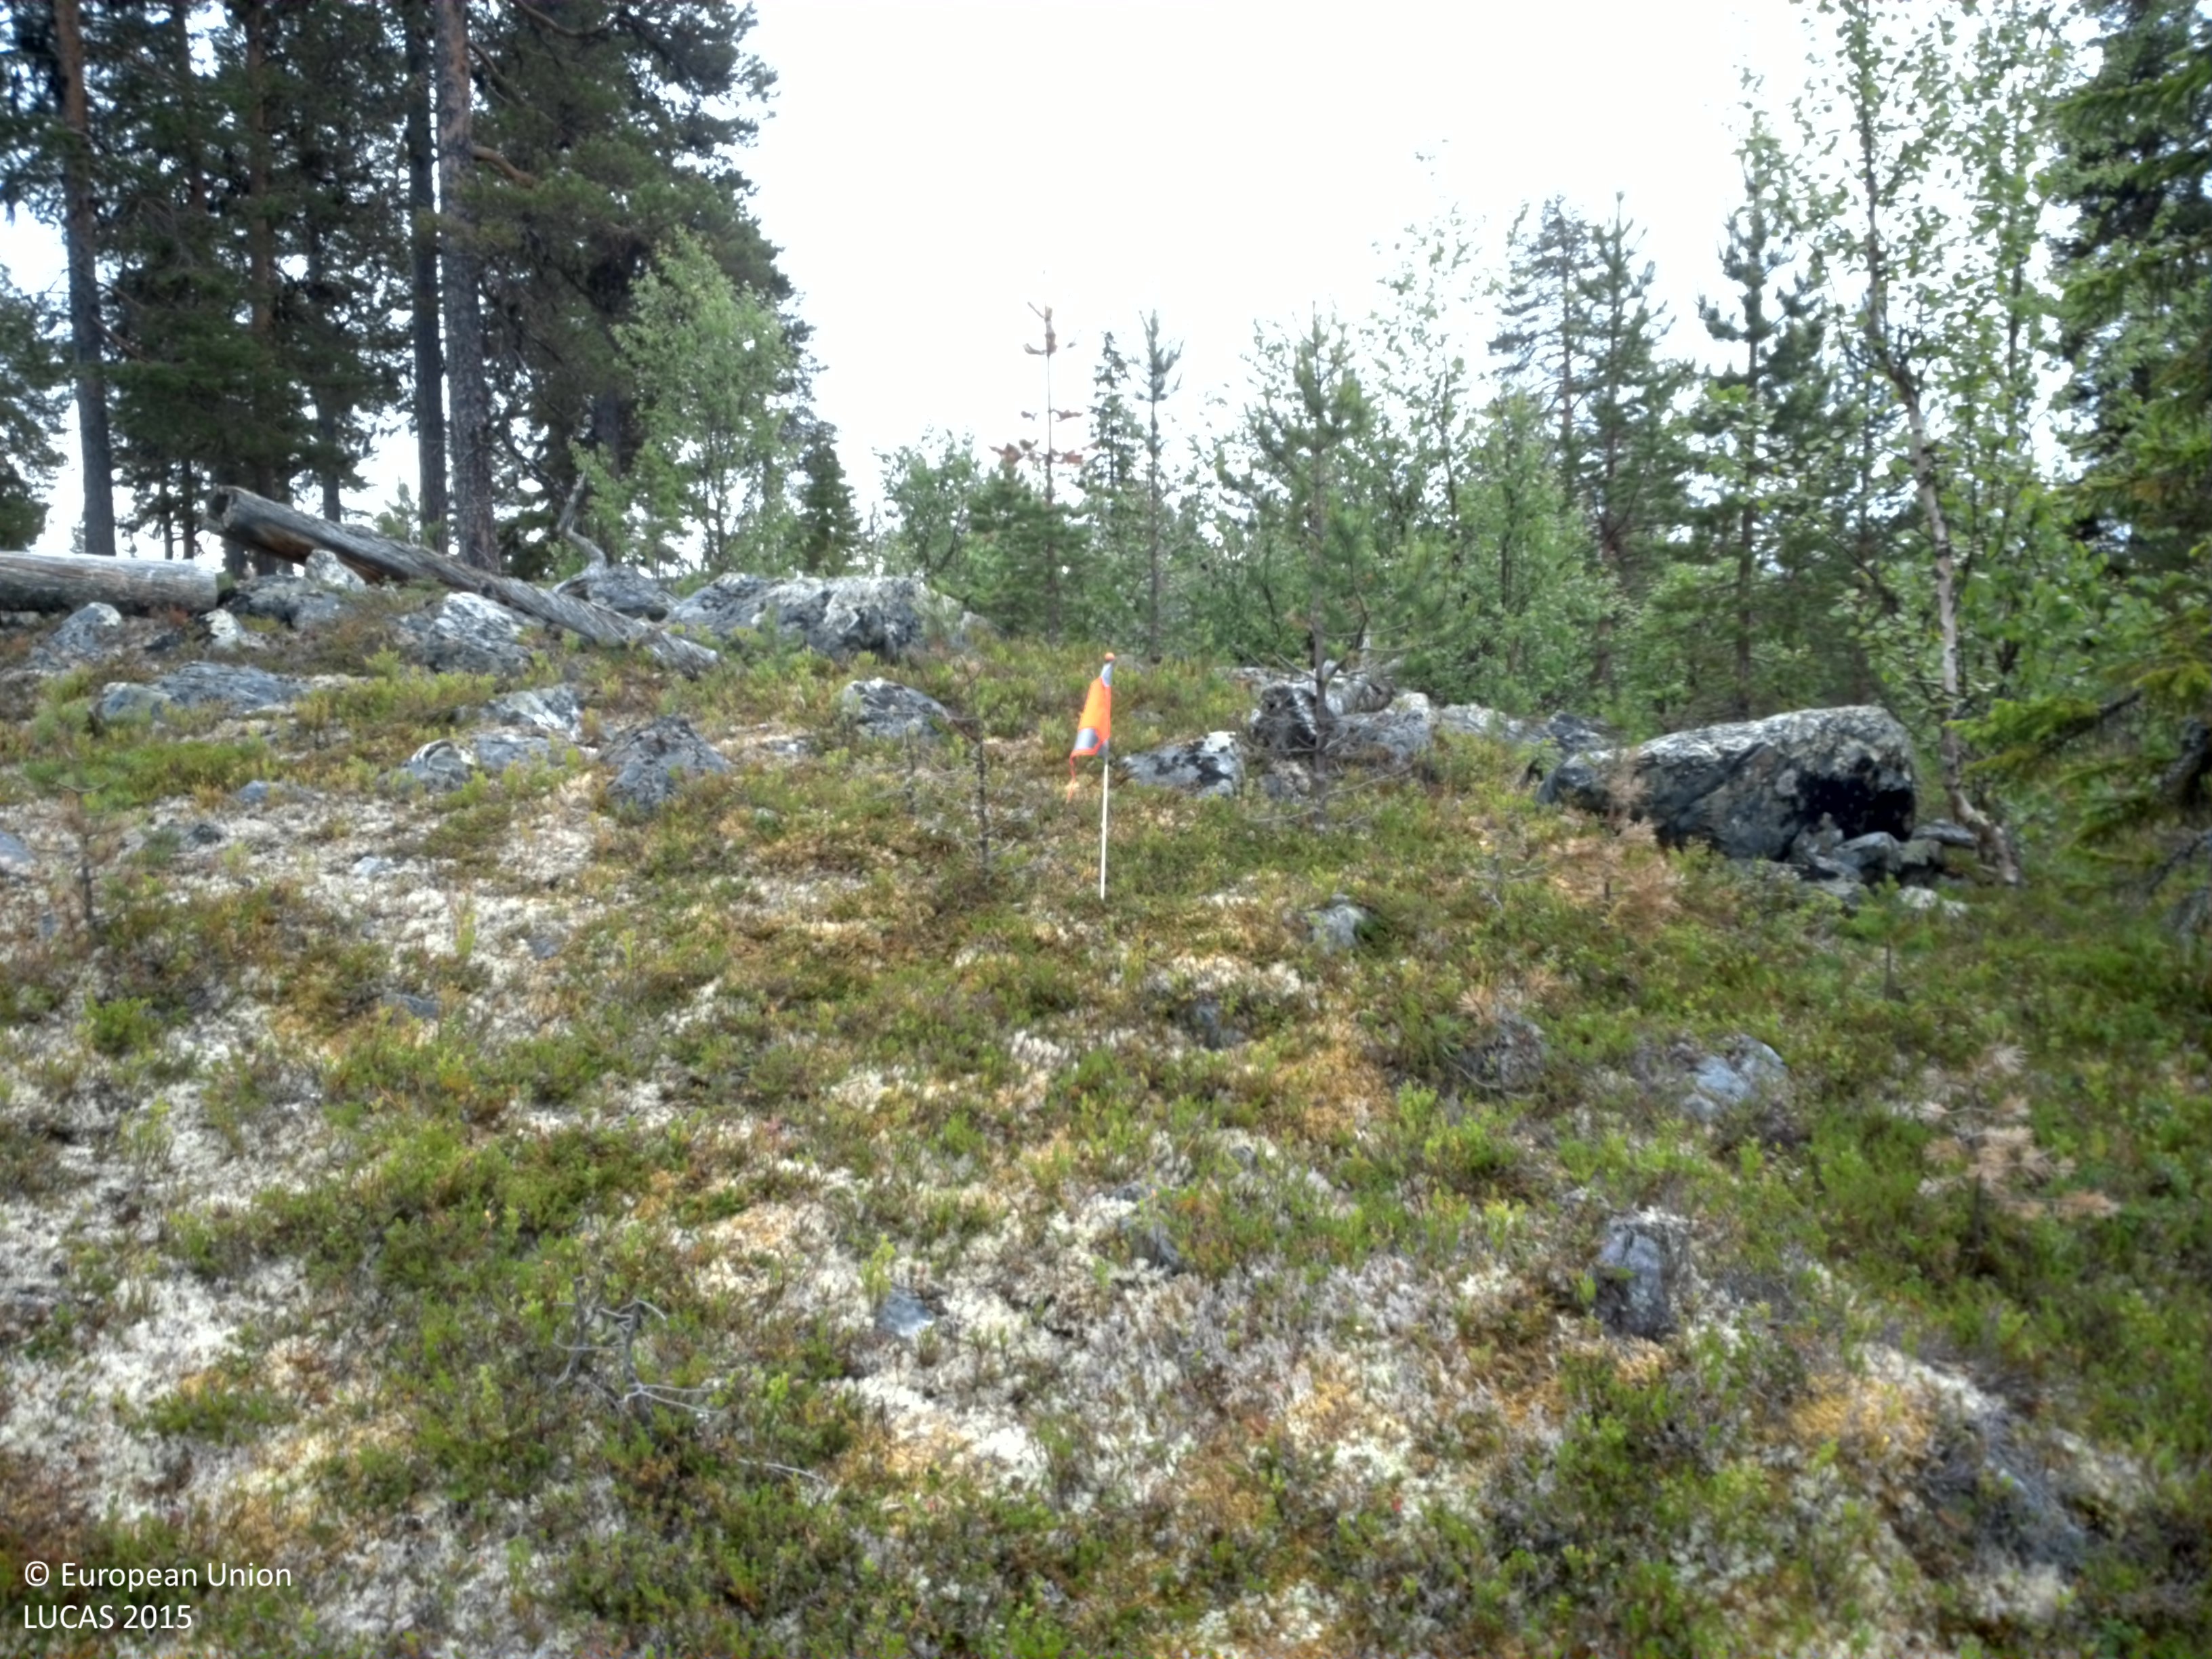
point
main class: Woodland
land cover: Pine dominated mixed woodland
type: exotic forest
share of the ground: 10 - 25 %
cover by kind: shrubs 35 %, lichens and mosses 30 %, consolidated bare surface 15 %, coniferous forest trees 10 %, broadleaved forest trees 10 %
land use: Forestry
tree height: < 5 m
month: August
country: SE
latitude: 65.0566
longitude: 16.1918
